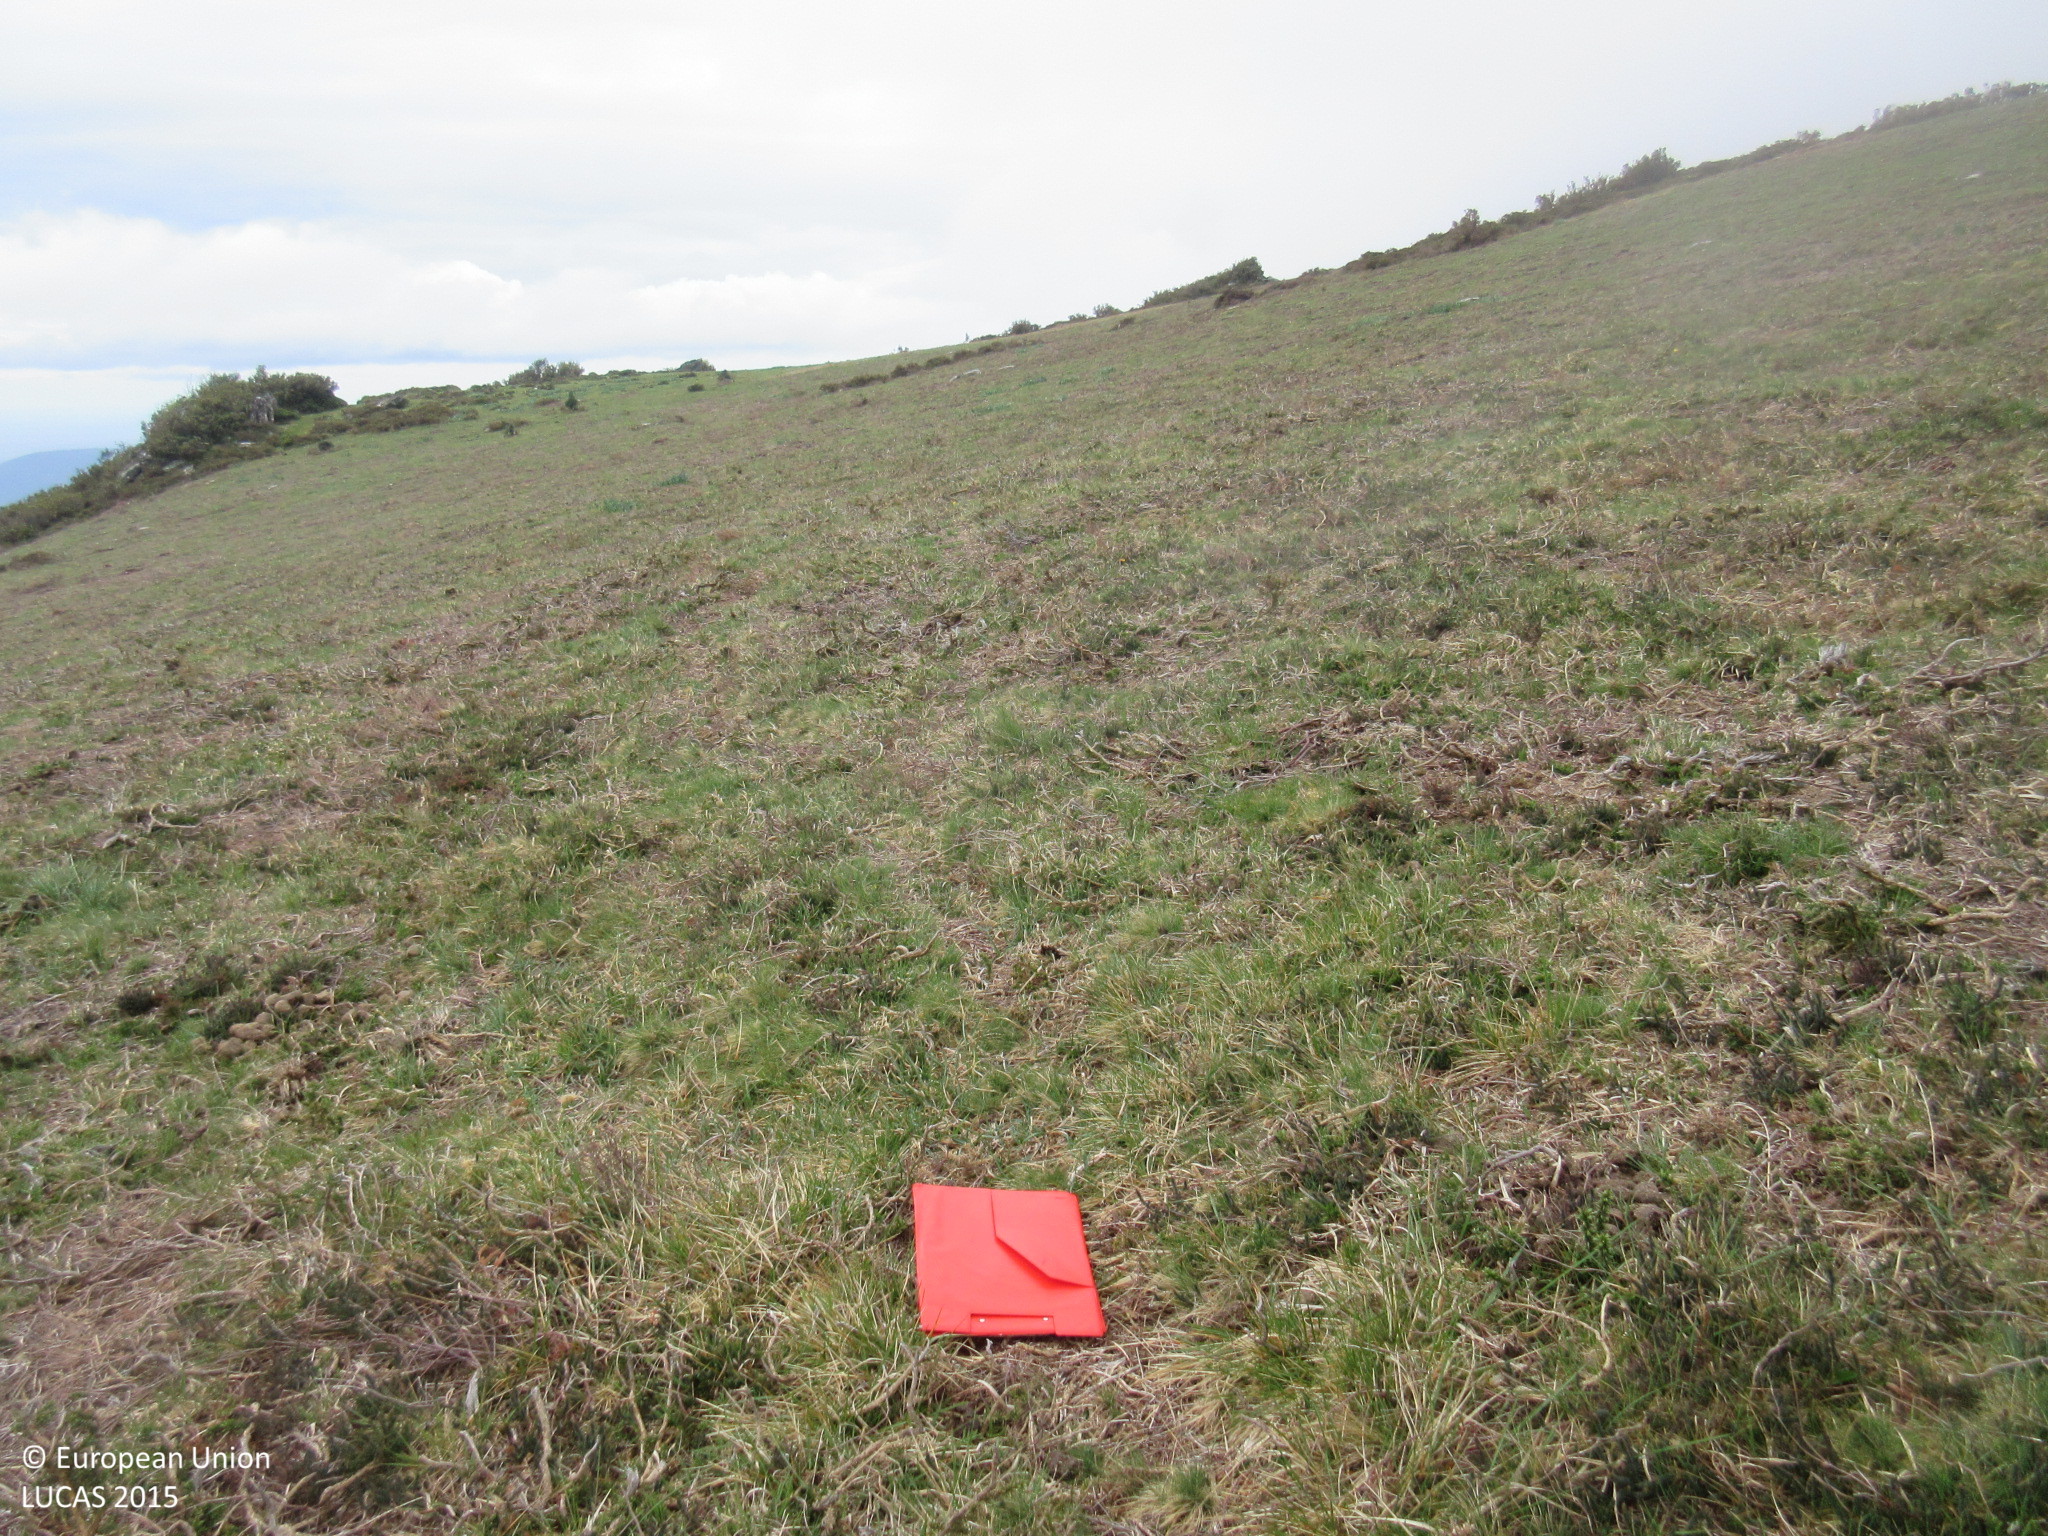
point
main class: Grassland
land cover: Grassland without tree/shrub cover
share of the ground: > 75 %
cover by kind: herbaceous plants 100 %
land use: Agriculture (excluding fallow land and kitchen gardens)
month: April
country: ES
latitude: 43.3613
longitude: -6.9831
